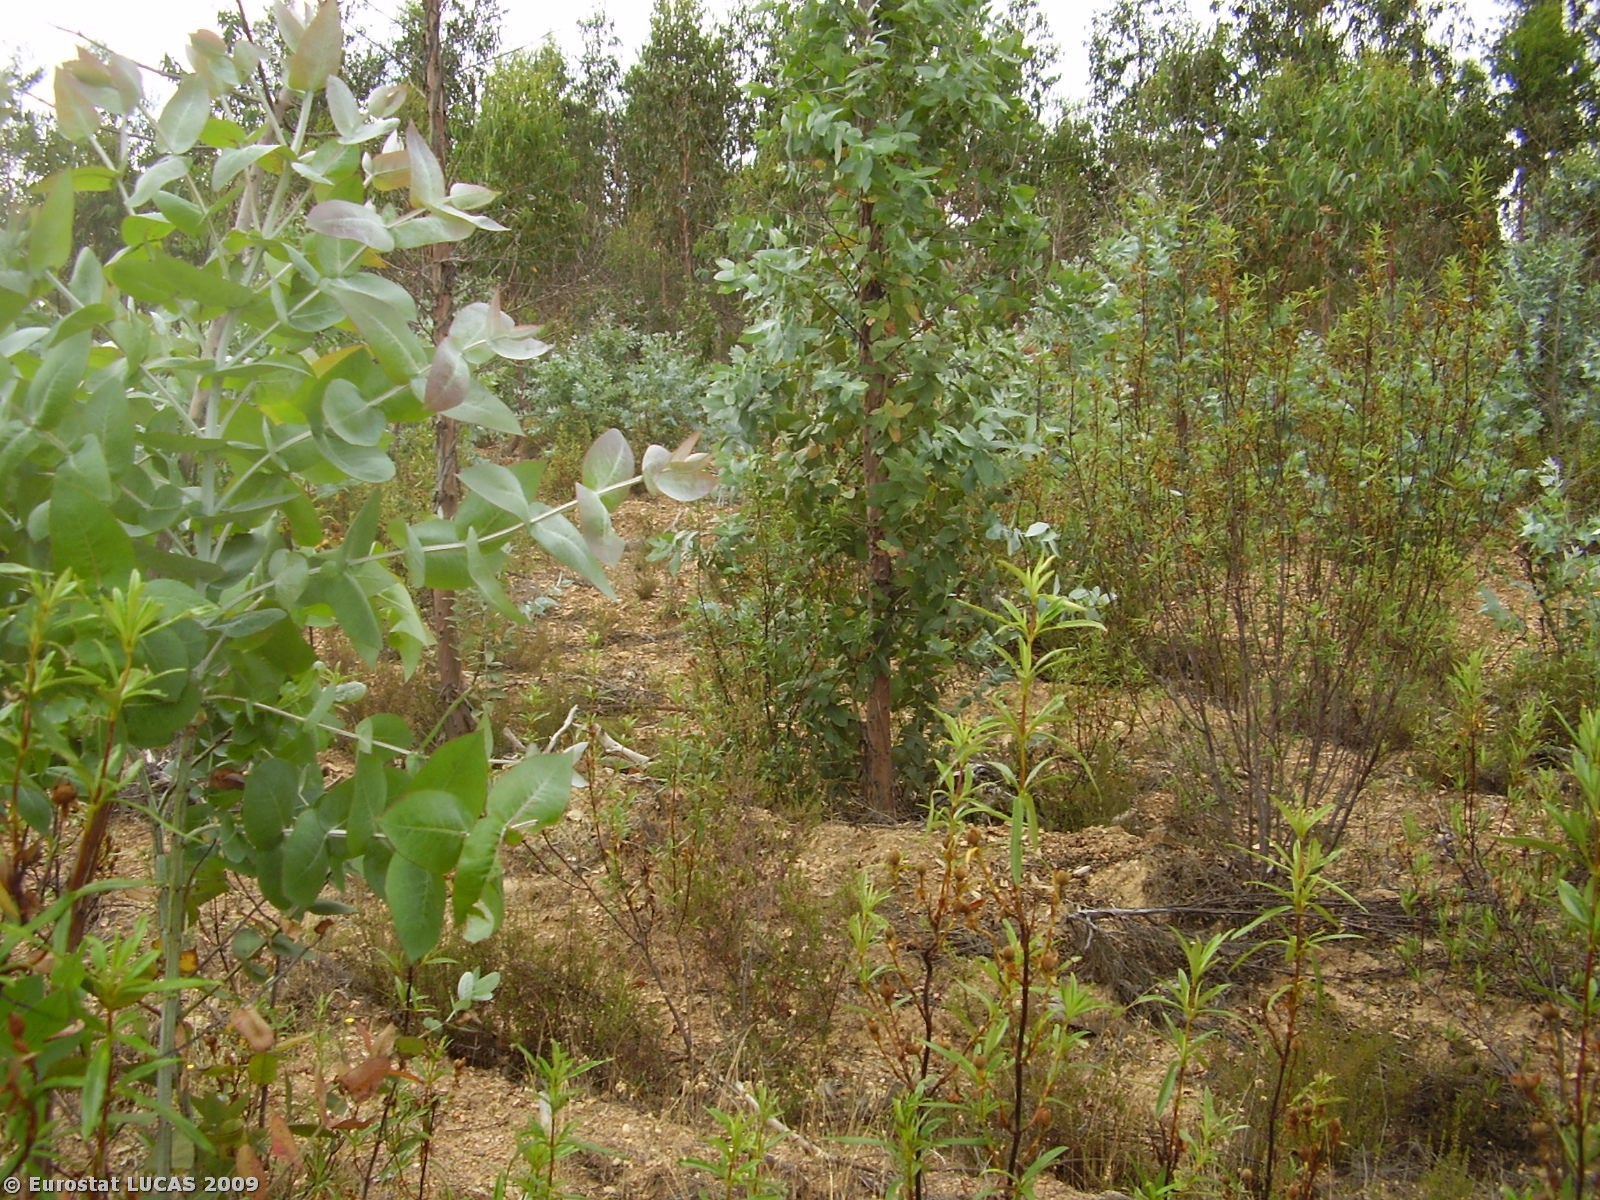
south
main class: Woodland
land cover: Broadleaved woodland
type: plantations and self-sown exotic forest
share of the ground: 10 - 25 %
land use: Forestry
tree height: > 5 m
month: July
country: PT
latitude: 39.5584
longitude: -8.0432
